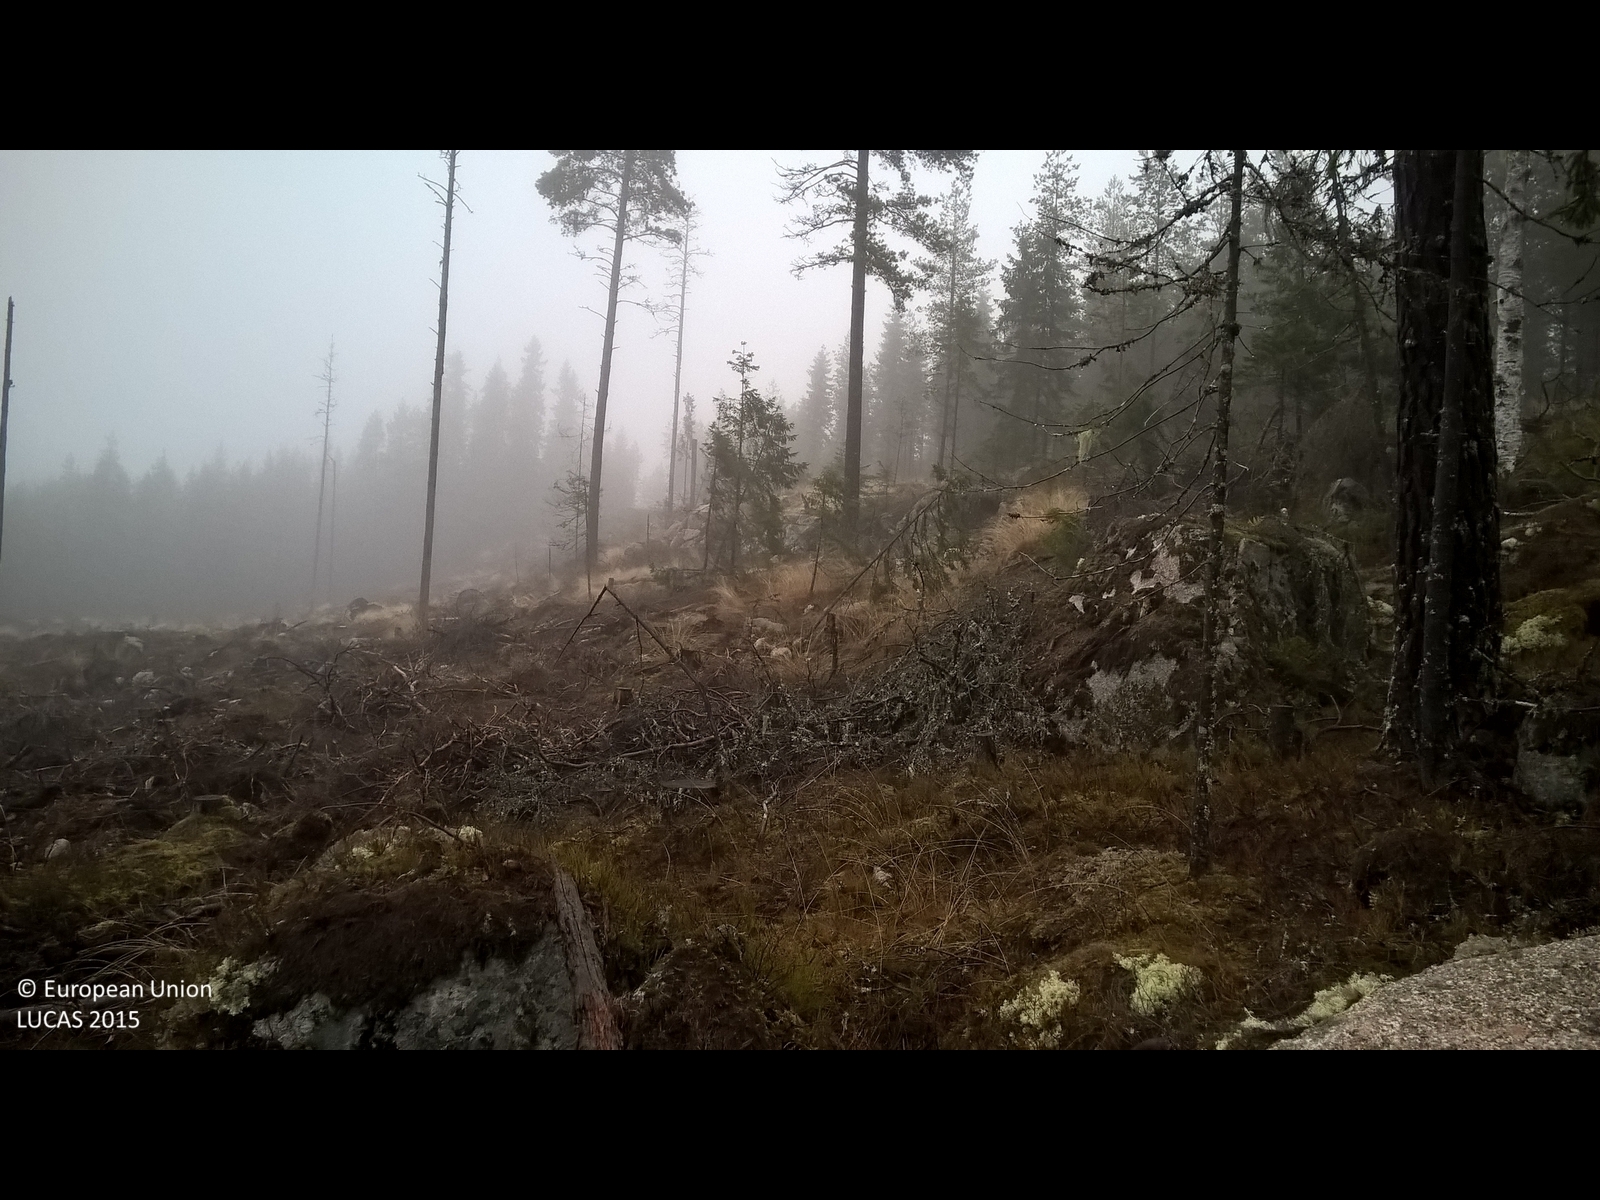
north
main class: Grassland
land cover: Grassland with sparse tree/shrub cover
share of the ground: > 75 %
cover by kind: lichens and mosses 55 %, herbaceous plants 30 %, shrubs 10 %, coniferous forest trees 5 %
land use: Forestry
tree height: > 5 m
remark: Clear cut
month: November
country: SE
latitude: 60.0908
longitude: 14.5022
